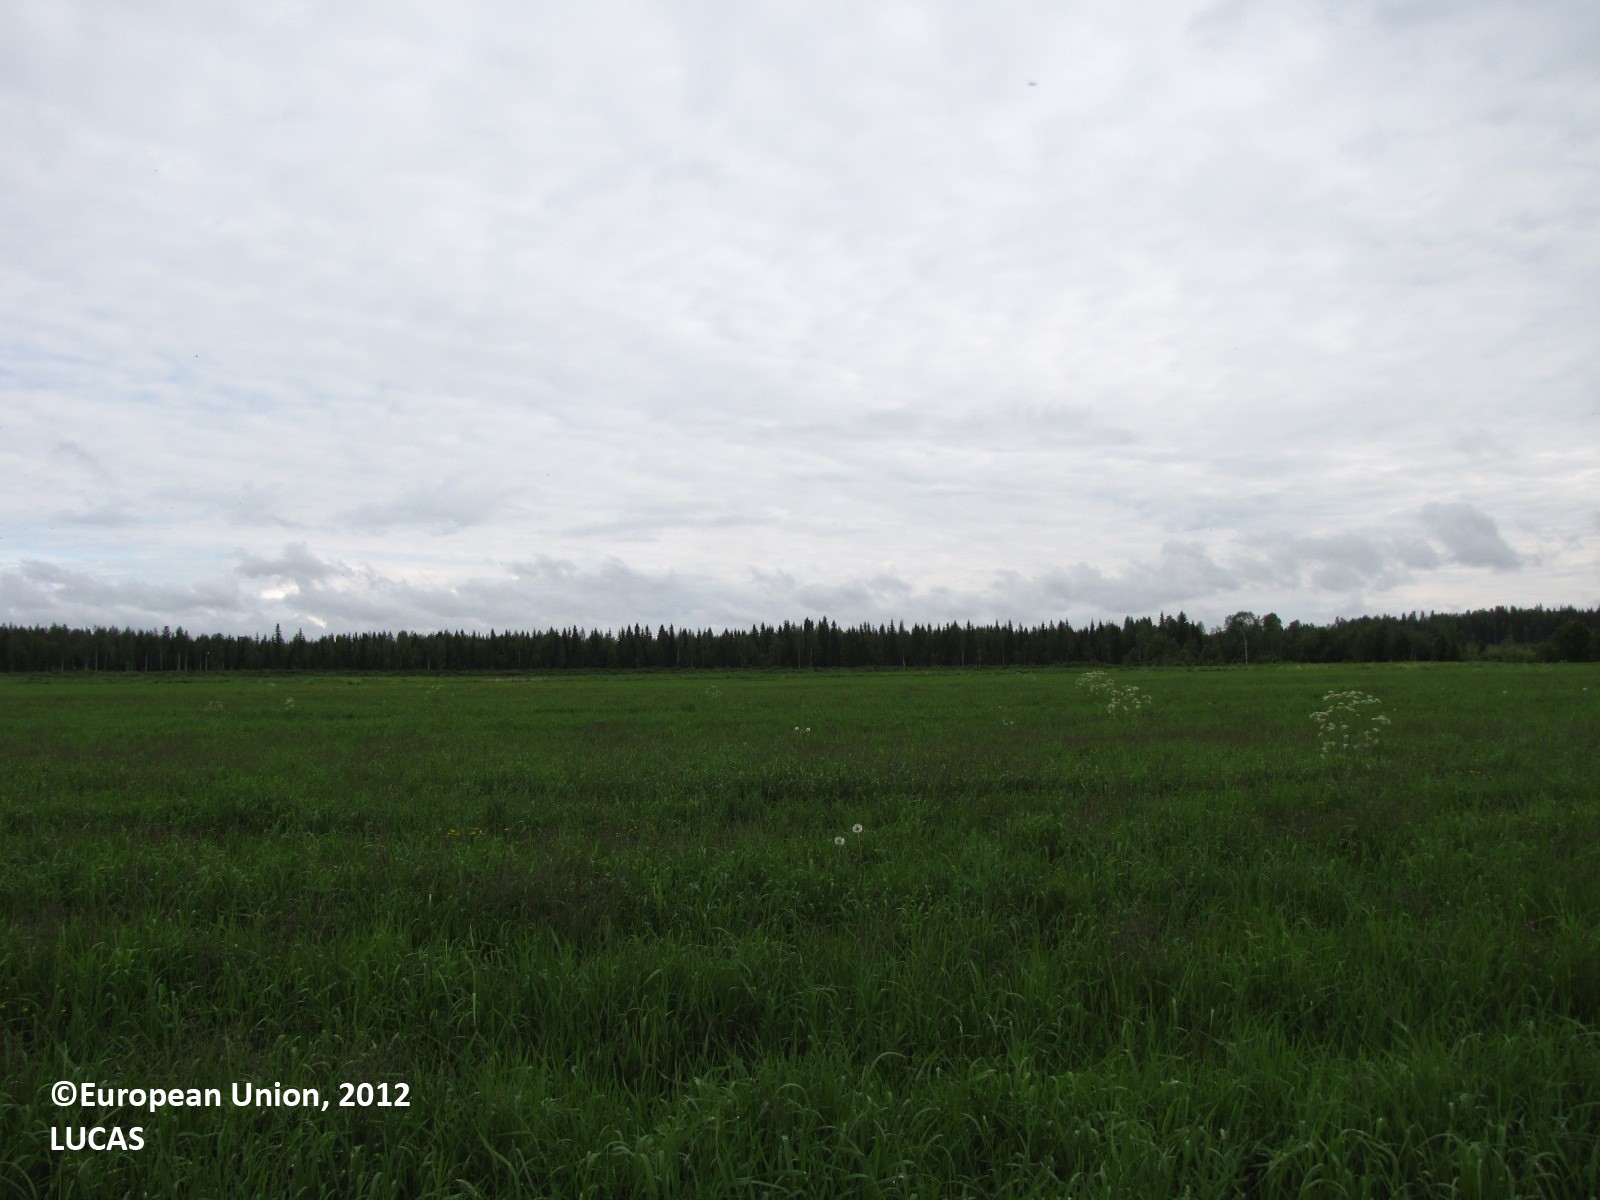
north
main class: Grassland
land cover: Grassland without tree/shrub cover
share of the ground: > 75 %
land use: Agriculture (excluding fallow land and kitchen gardens)
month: June
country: FI
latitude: 66.1630
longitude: 24.7104
